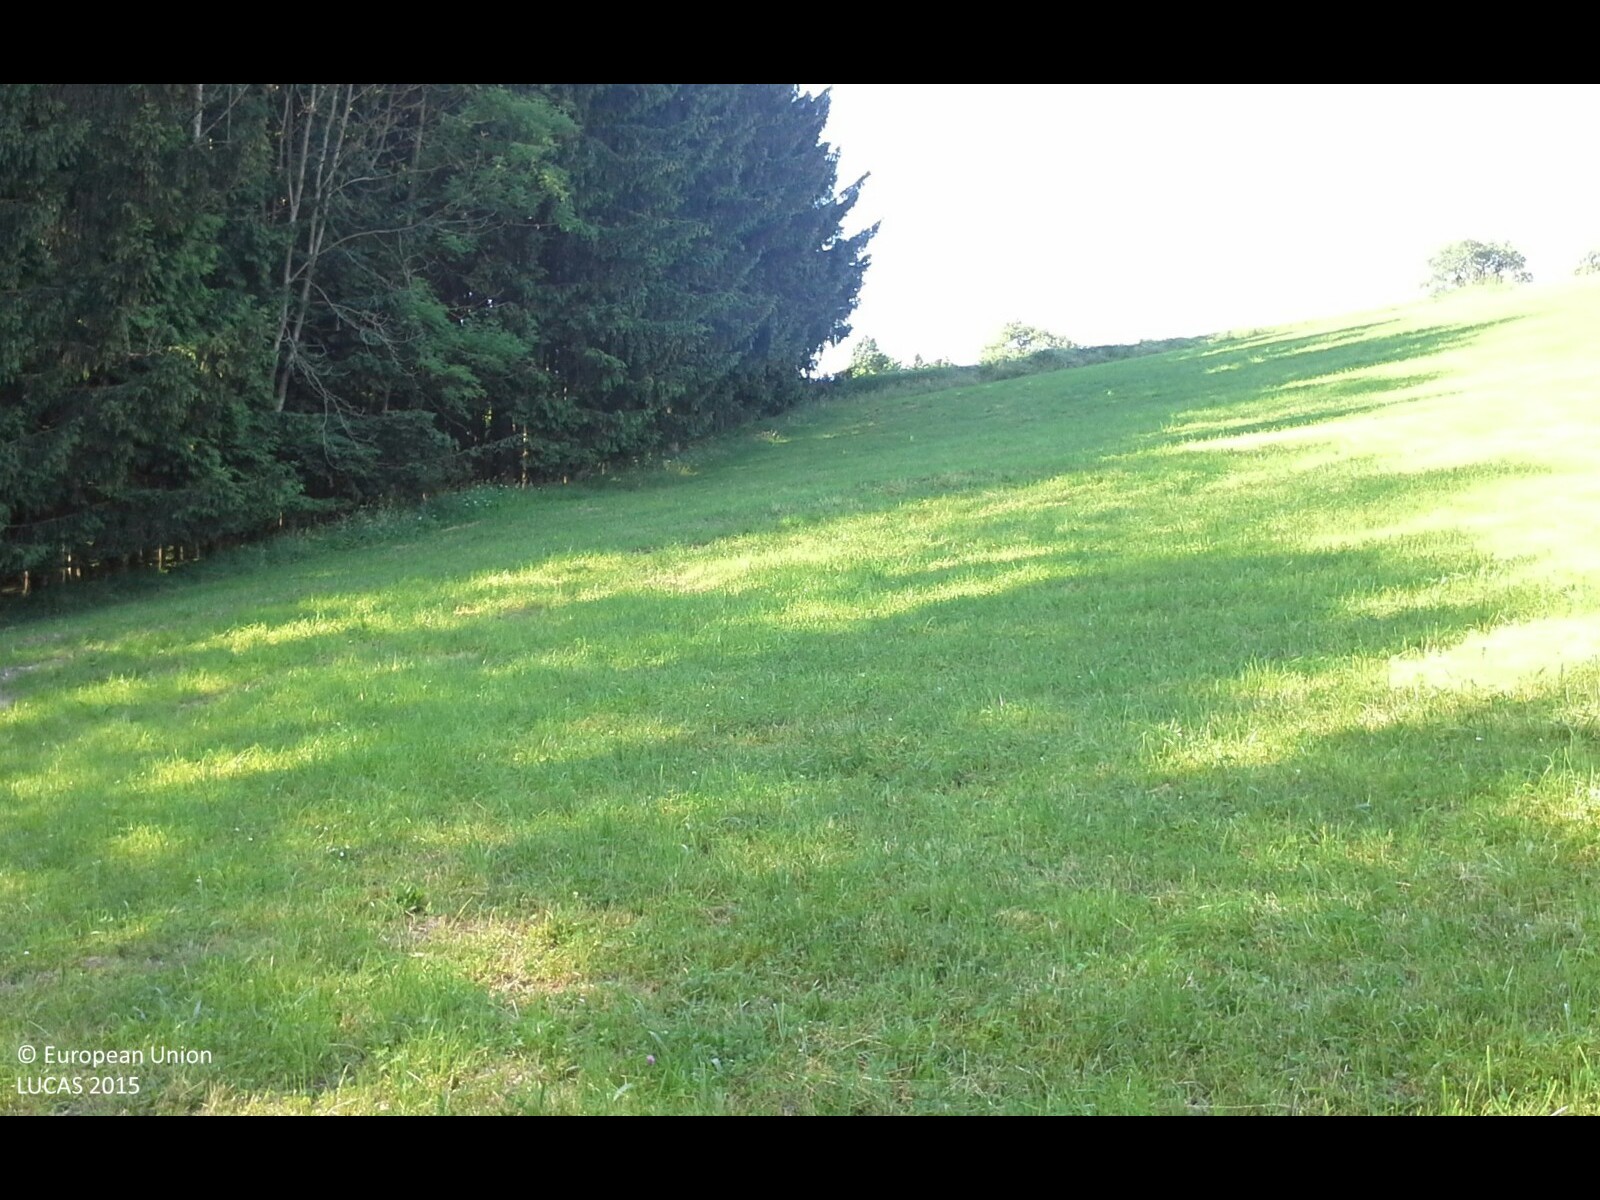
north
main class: Grassland
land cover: Grassland without tree/shrub cover
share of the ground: > 75 %
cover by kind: herbaceous plants 100 %
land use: Agriculture (excluding fallow land and kitchen gardens)
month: June
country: AT
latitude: 48.1024
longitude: 14.7679
